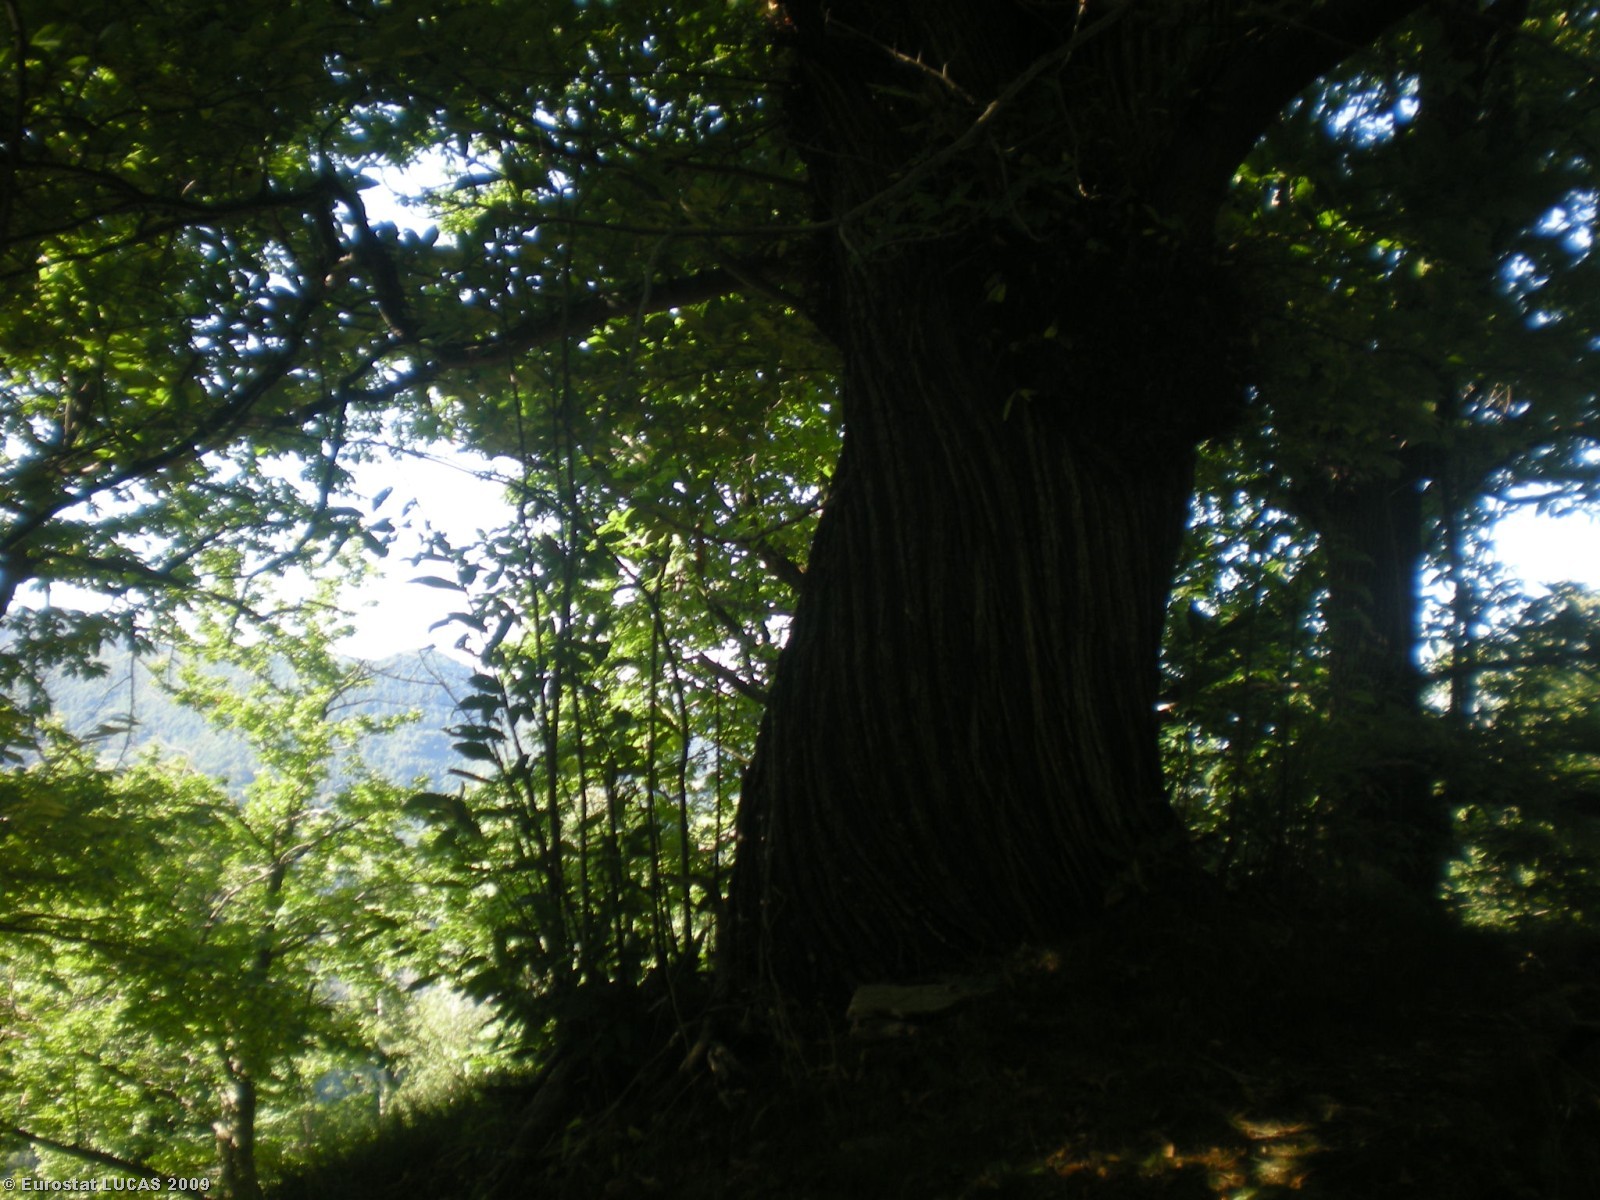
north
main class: Woodland
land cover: Broadleaved woodland
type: mesophytic deciduous forest
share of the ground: > 75 %
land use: Forestry
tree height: > 5 m
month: July
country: IT
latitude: 44.5519
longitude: 7.3743
